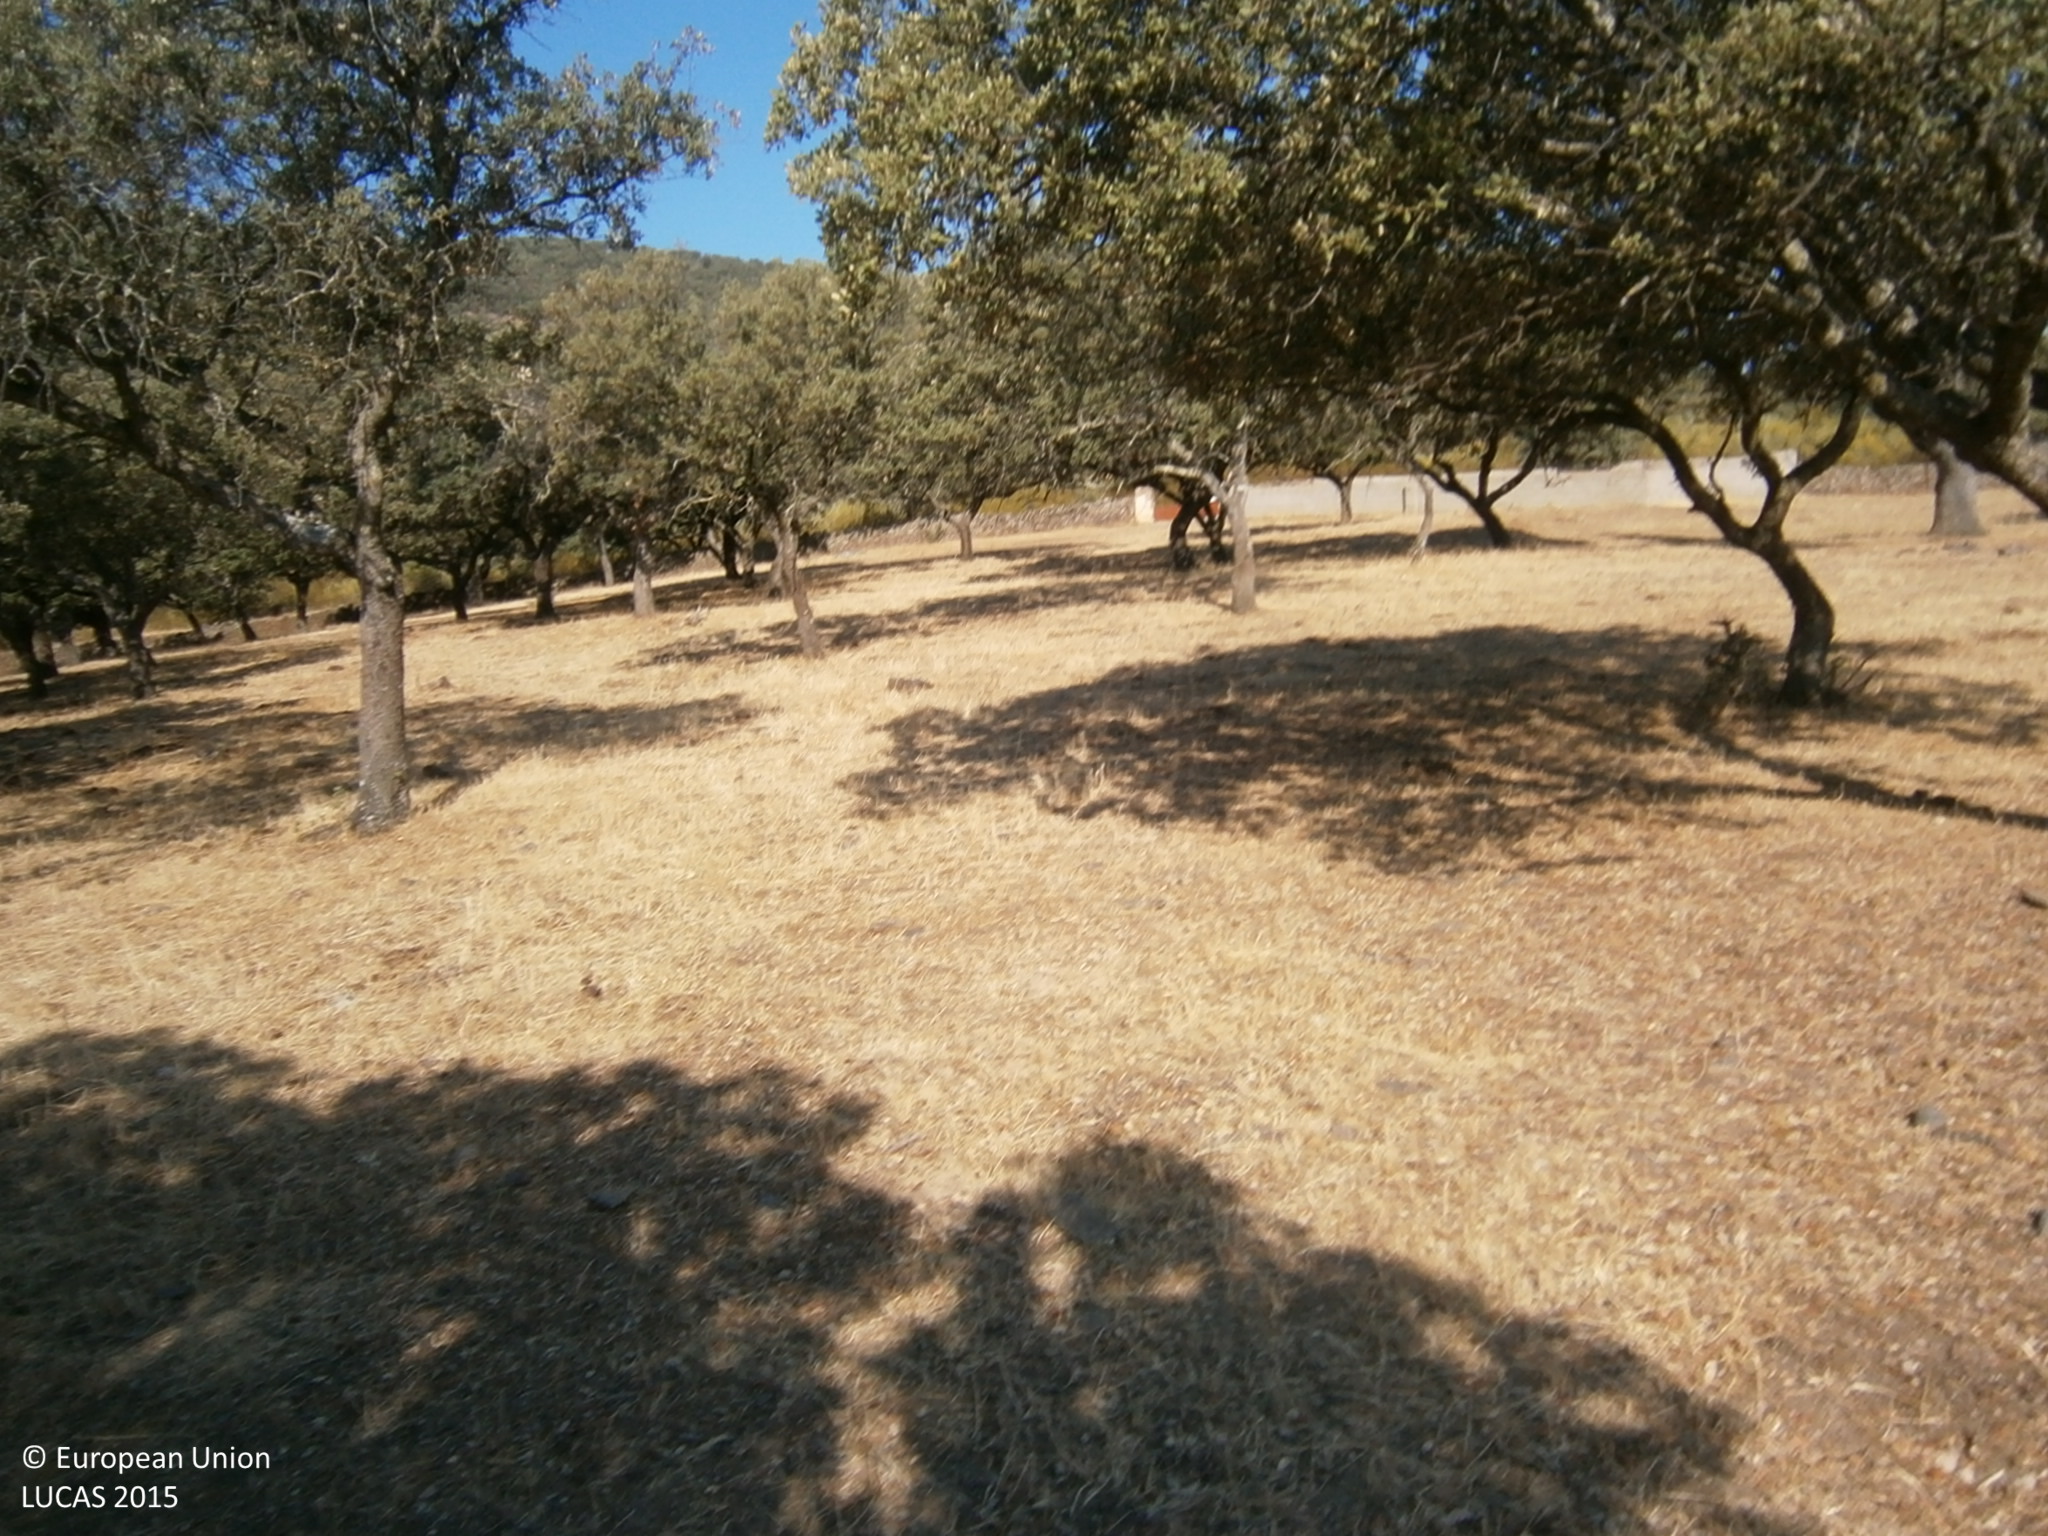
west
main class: Woodland
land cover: Broadleaved woodland
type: broadleaved evergreen forest
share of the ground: > 75 %
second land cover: Spontaneously vegetated surfaces
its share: > 75 %
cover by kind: broadleaved forest trees 90 %, unconsolidated bare surface 5 %
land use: Forestry
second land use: Agriculture (excluding fallow land and kitchen gardens)
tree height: > 5 m
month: June
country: ES
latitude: 38.5565
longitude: -6.7561
